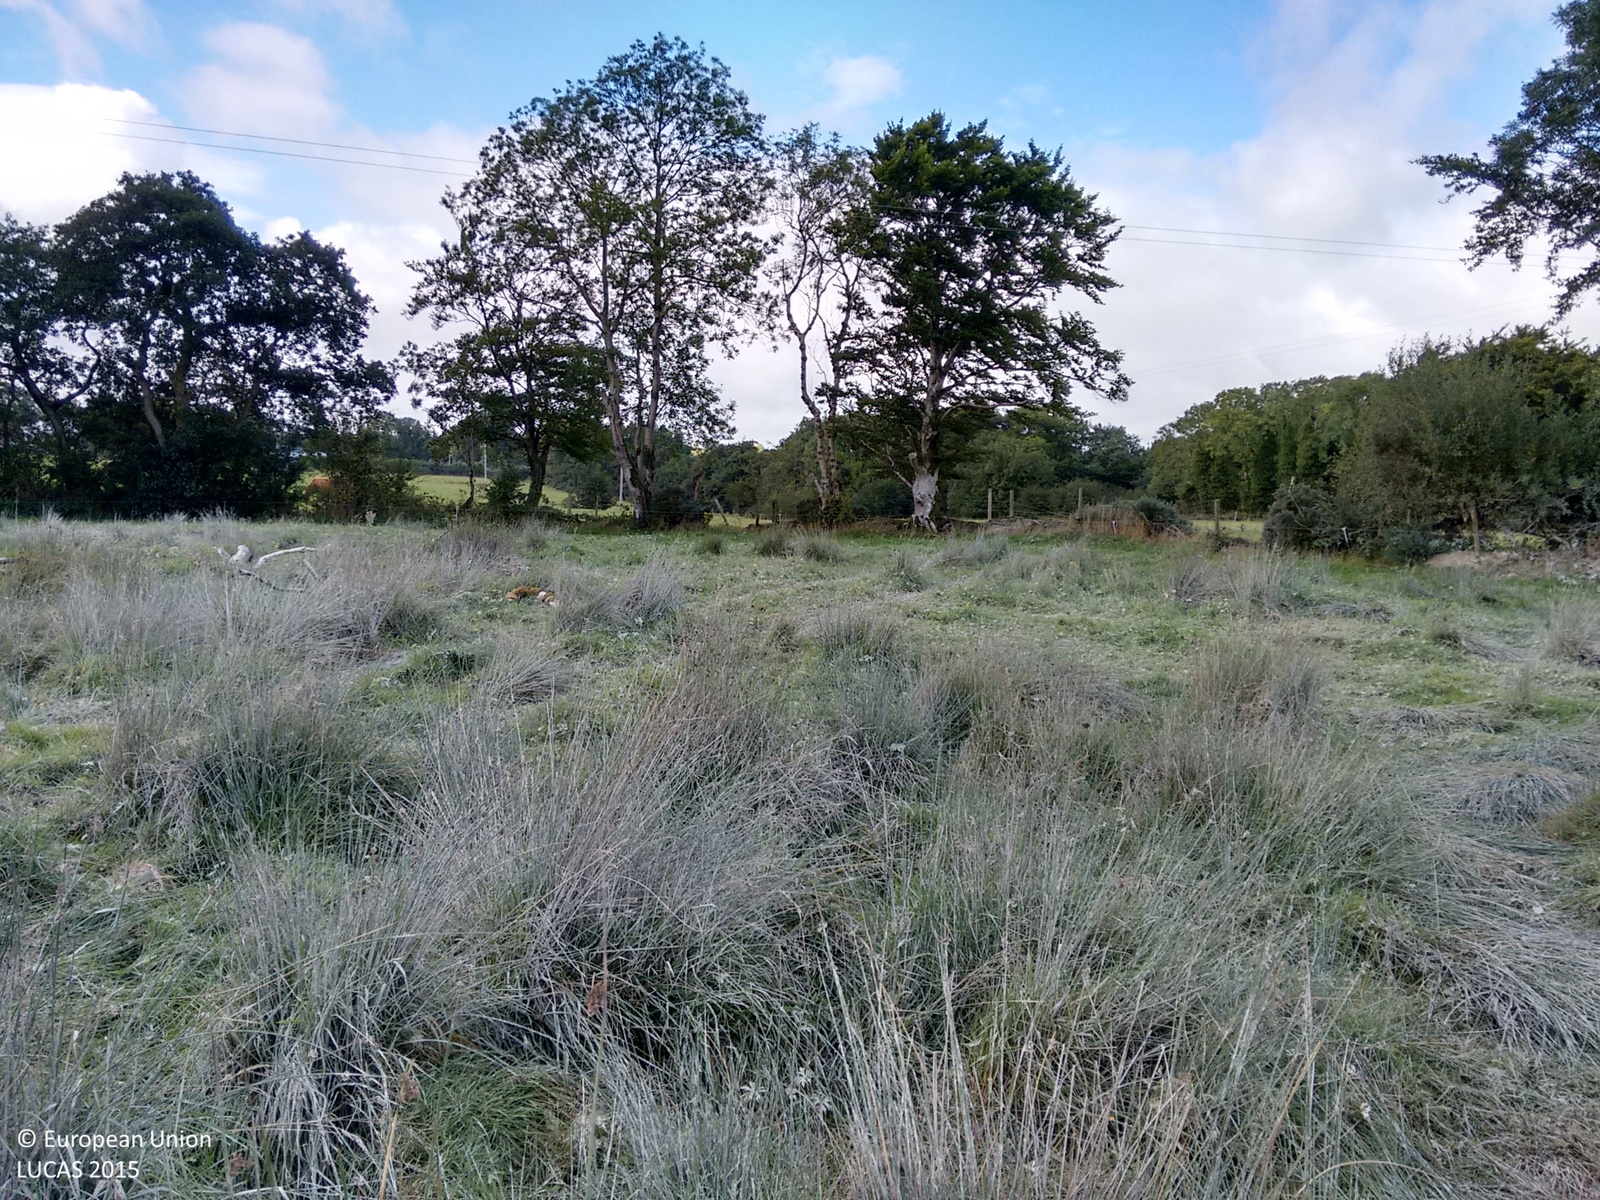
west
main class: Grassland
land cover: Grassland without tree/shrub cover
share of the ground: > 75 %
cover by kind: herbaceous plants 100 %
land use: Agriculture (excluding fallow land and kitchen gardens)
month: September
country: IE
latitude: 54.1987
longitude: -6.8281
